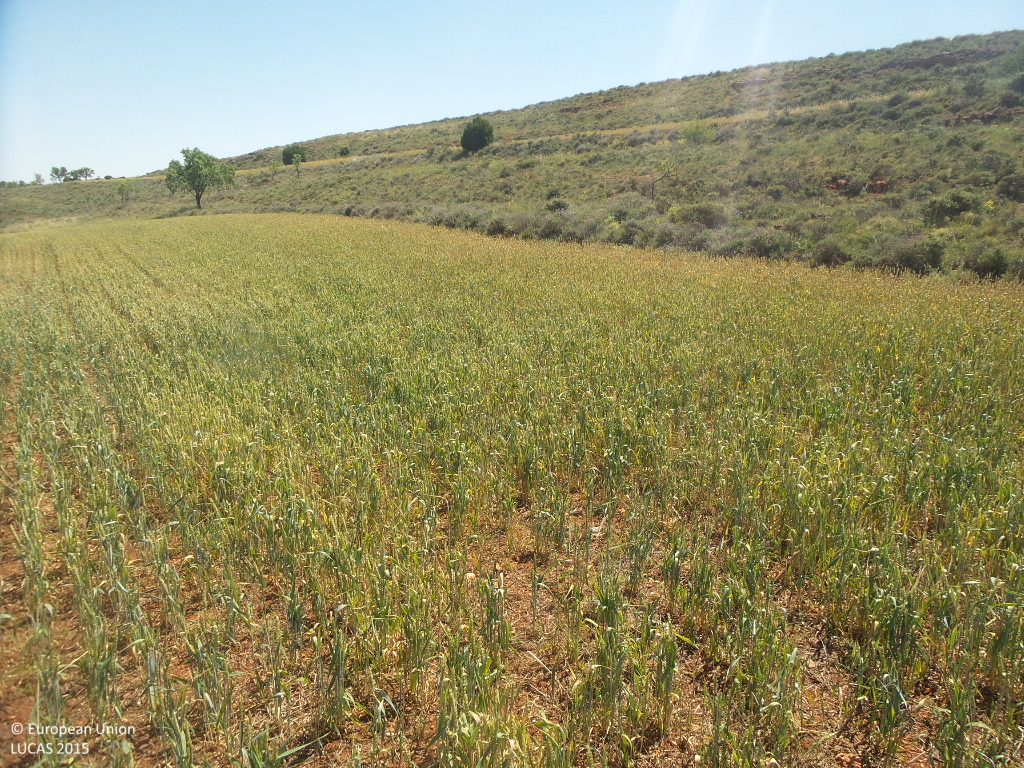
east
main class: Cropland
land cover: Common wheat
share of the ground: > 75 %
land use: Agriculture (excluding fallow land and kitchen gardens)
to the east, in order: Common wheat; Shrubland without tree cover; Common wheat; Shrubland without tree cover; Common wheat; Shrubland without tree cover; Rye; Shruby margins; Tracks; Shruby margins; Common wheat; Shrubland without tree cover; Common wheat
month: June
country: ES
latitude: 41.4014
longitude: -3.0671
